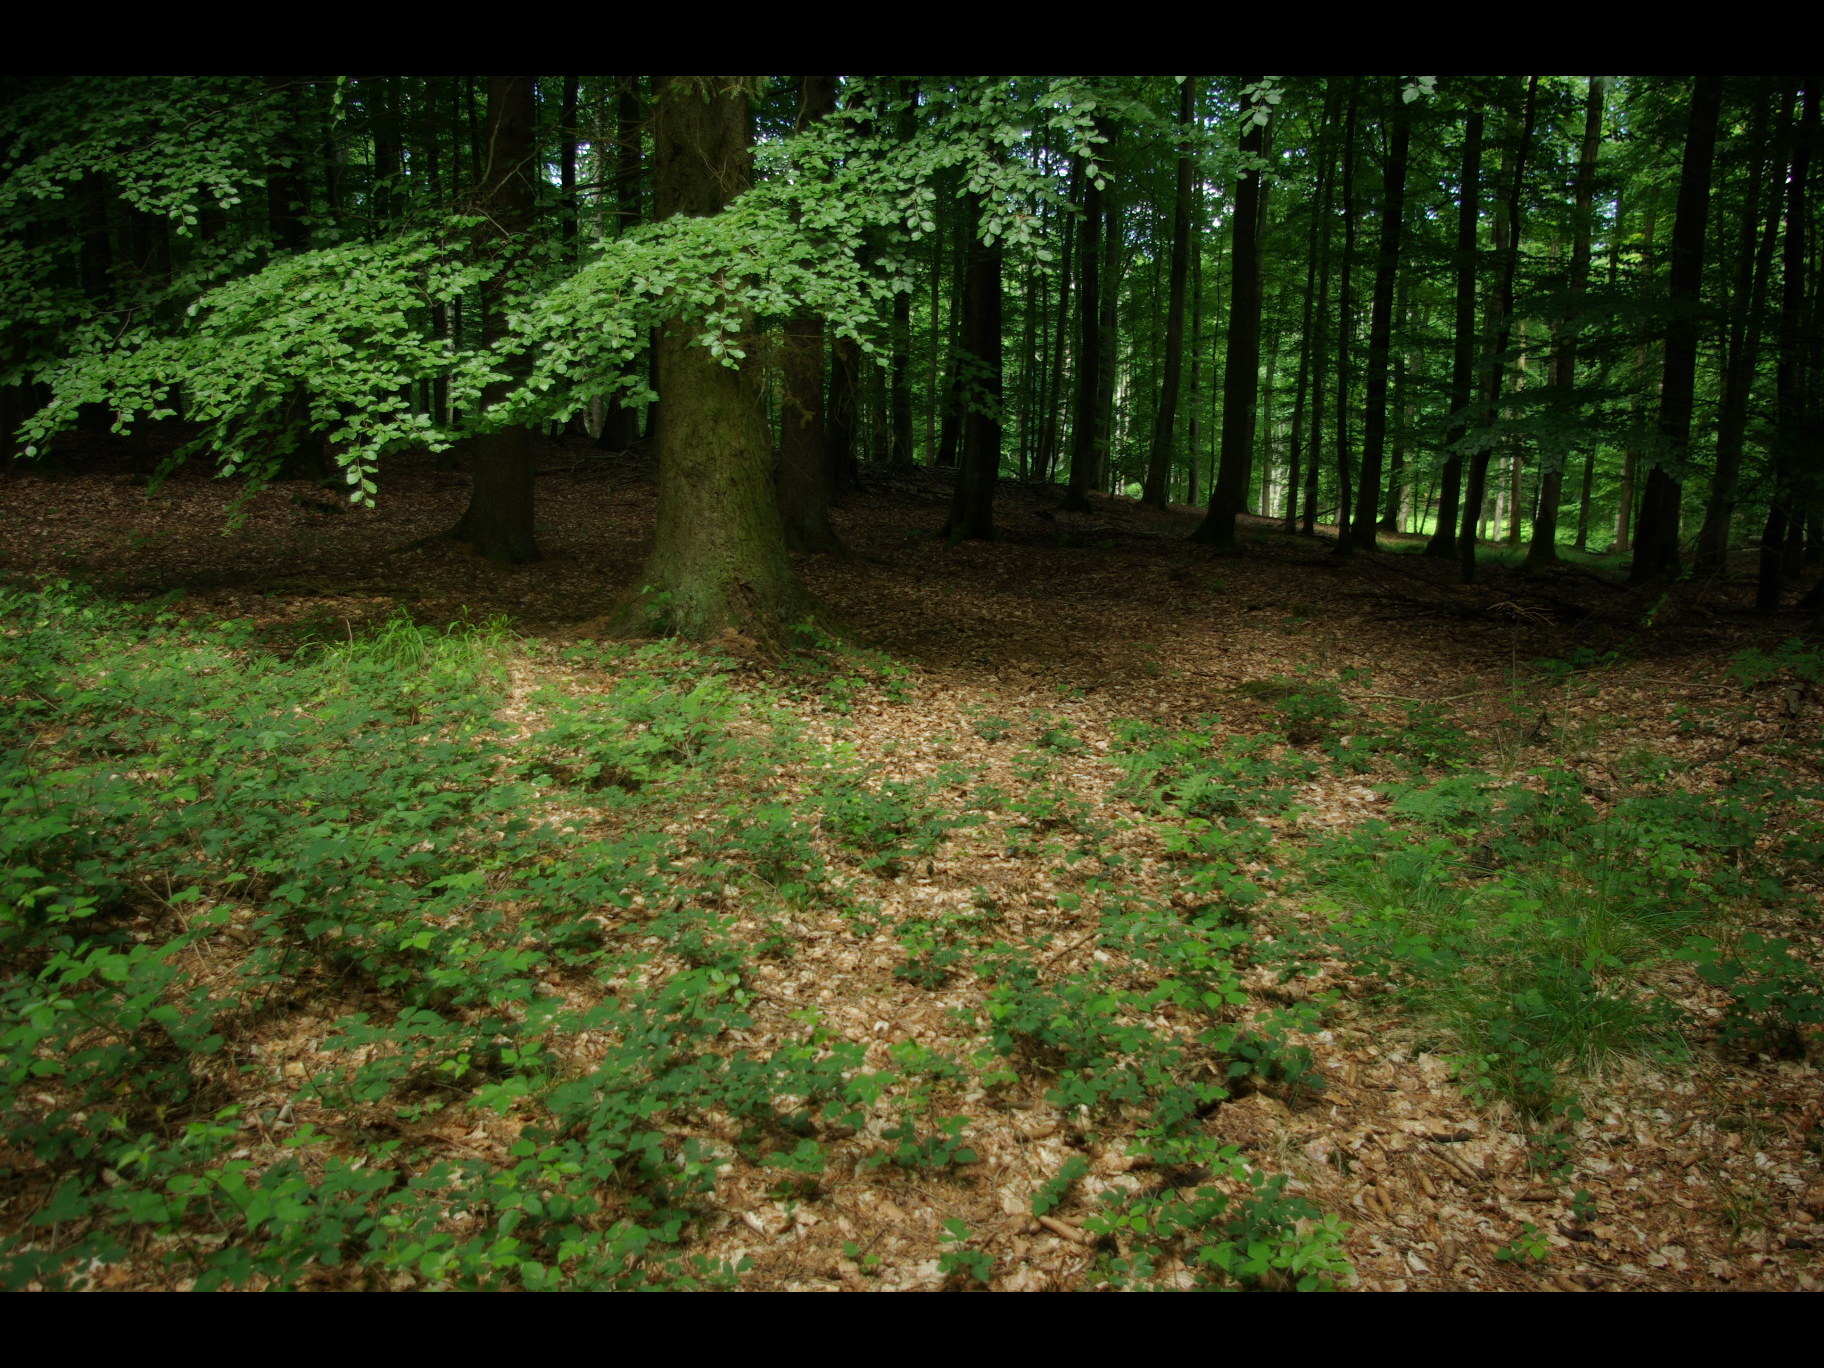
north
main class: Woodland
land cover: Other mixed woodland
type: hemiboreal forest and nemoral coniferous forest and mixed broadleaved-coniferous forest
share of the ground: > 75 %
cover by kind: coniferous forest trees 45 %, broadleaved forest trees 45 %, herbaceous plants 5 %, unconsolidated bare surface 5 %
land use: Forestry
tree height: > 5 m
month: June
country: DE
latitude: 54.3005
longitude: 9.8925
